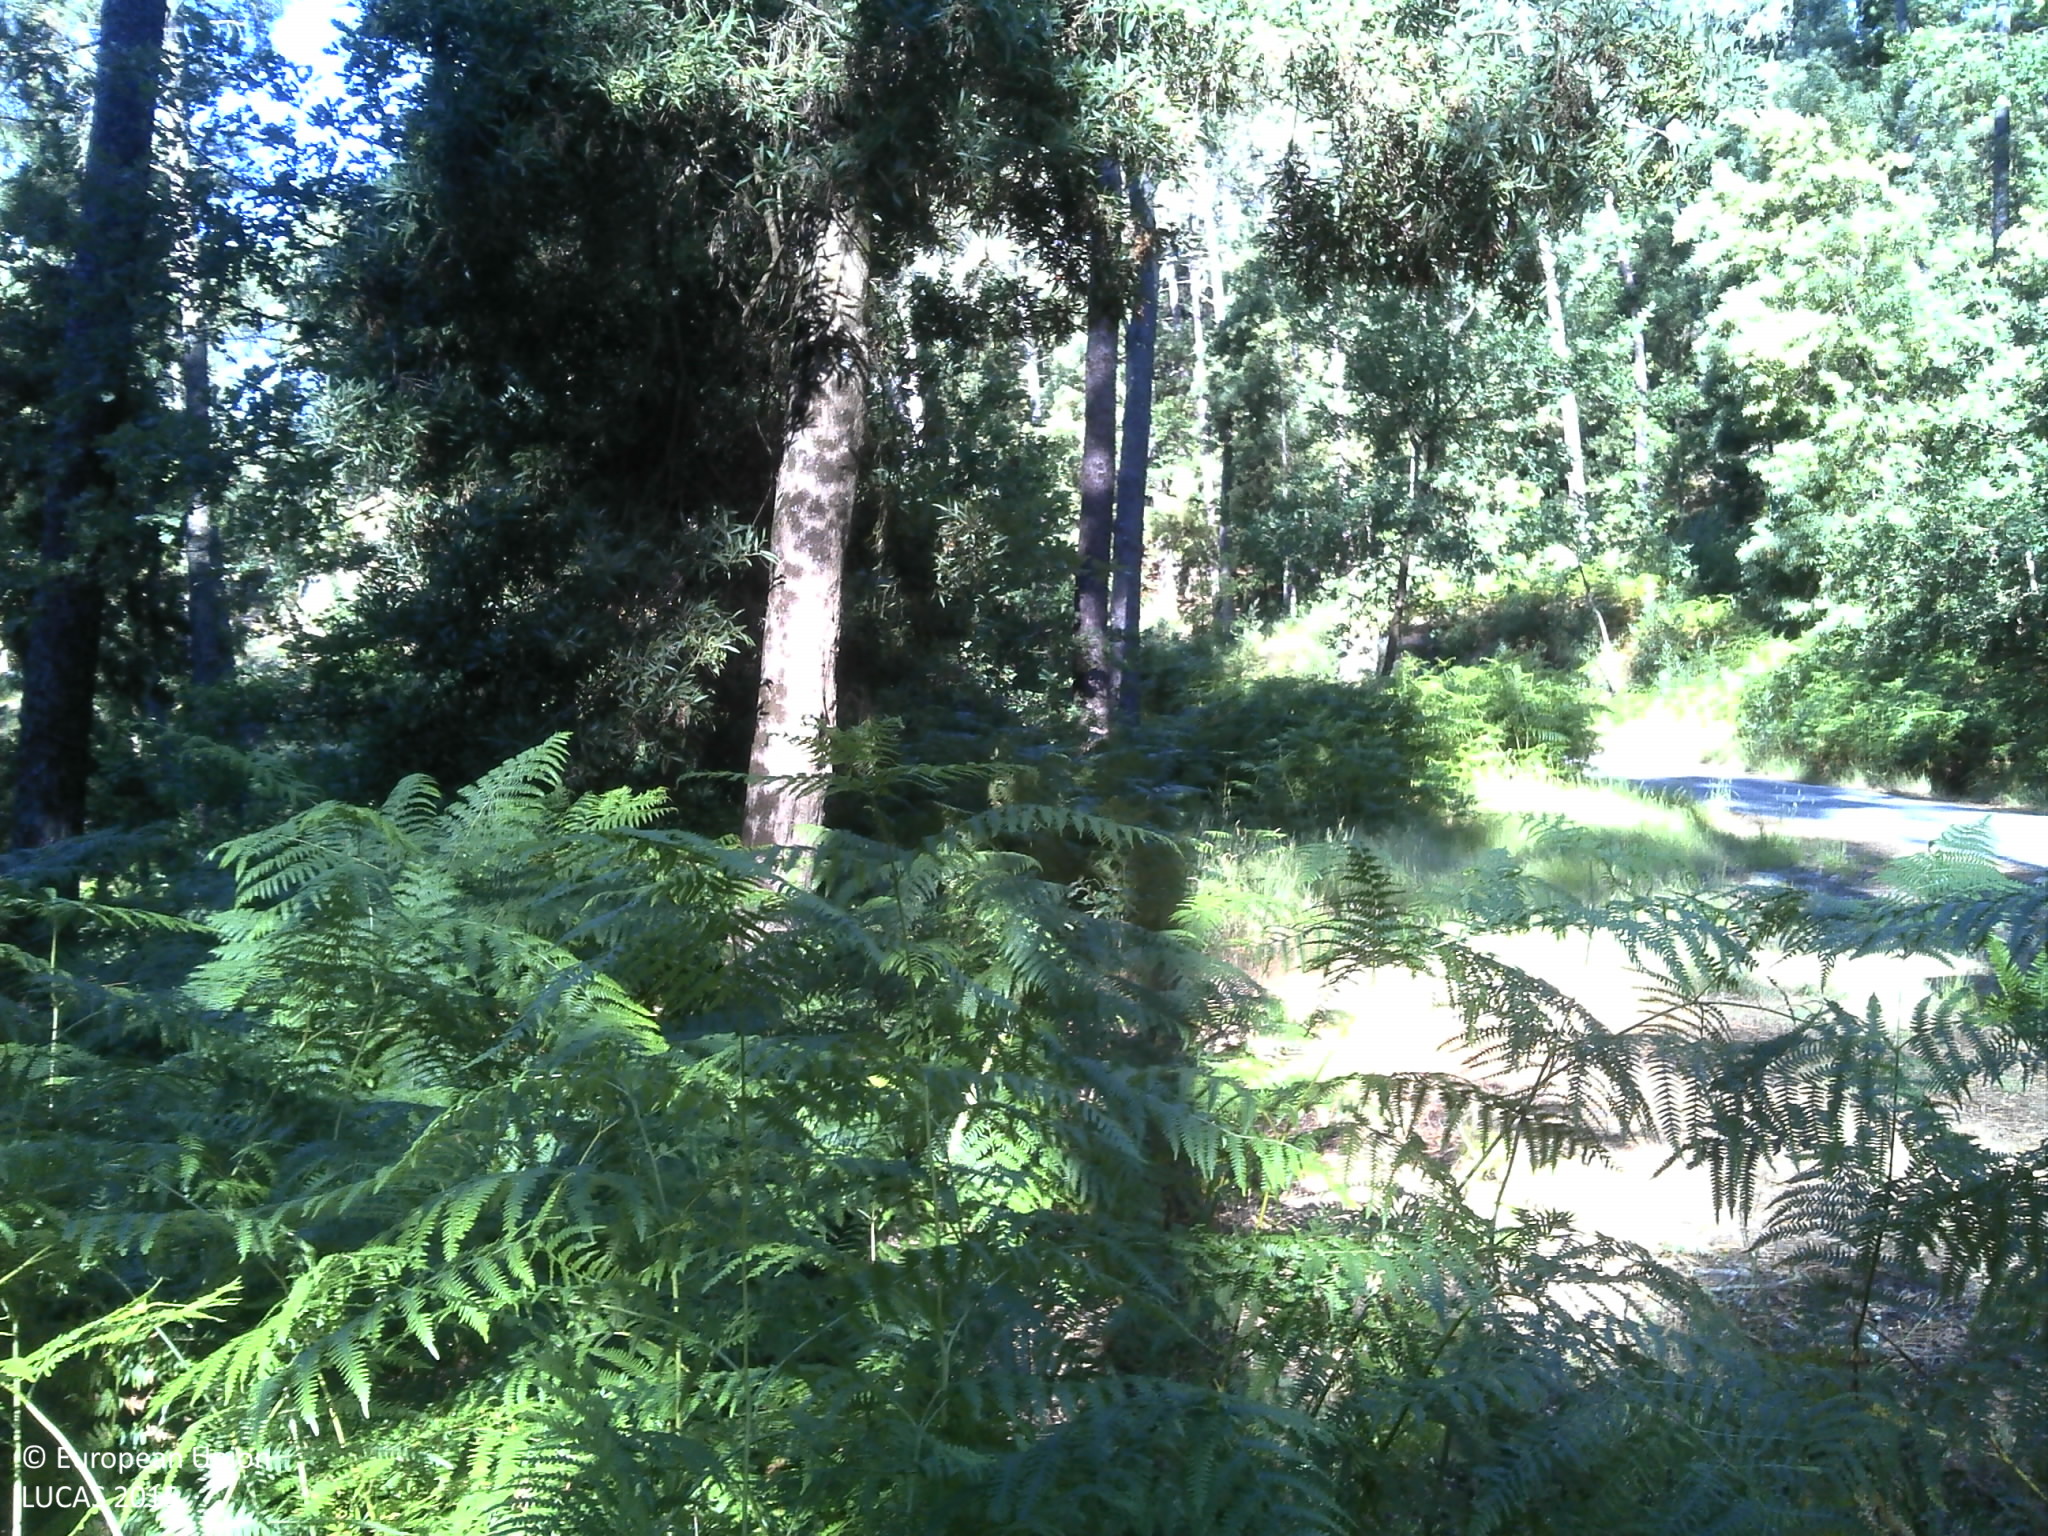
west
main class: Woodland
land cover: Pine dominated coniferous woodland
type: coniferous forest of the mediterranean region
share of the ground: 50 - 75 %
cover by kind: coniferous forest trees 60 %, shrubs 25 %, unconsolidated bare surface 10 %, herbaceous plants 5 %
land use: Forestry
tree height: > 5 m
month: June
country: PT
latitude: 40.6828
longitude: -7.9567
